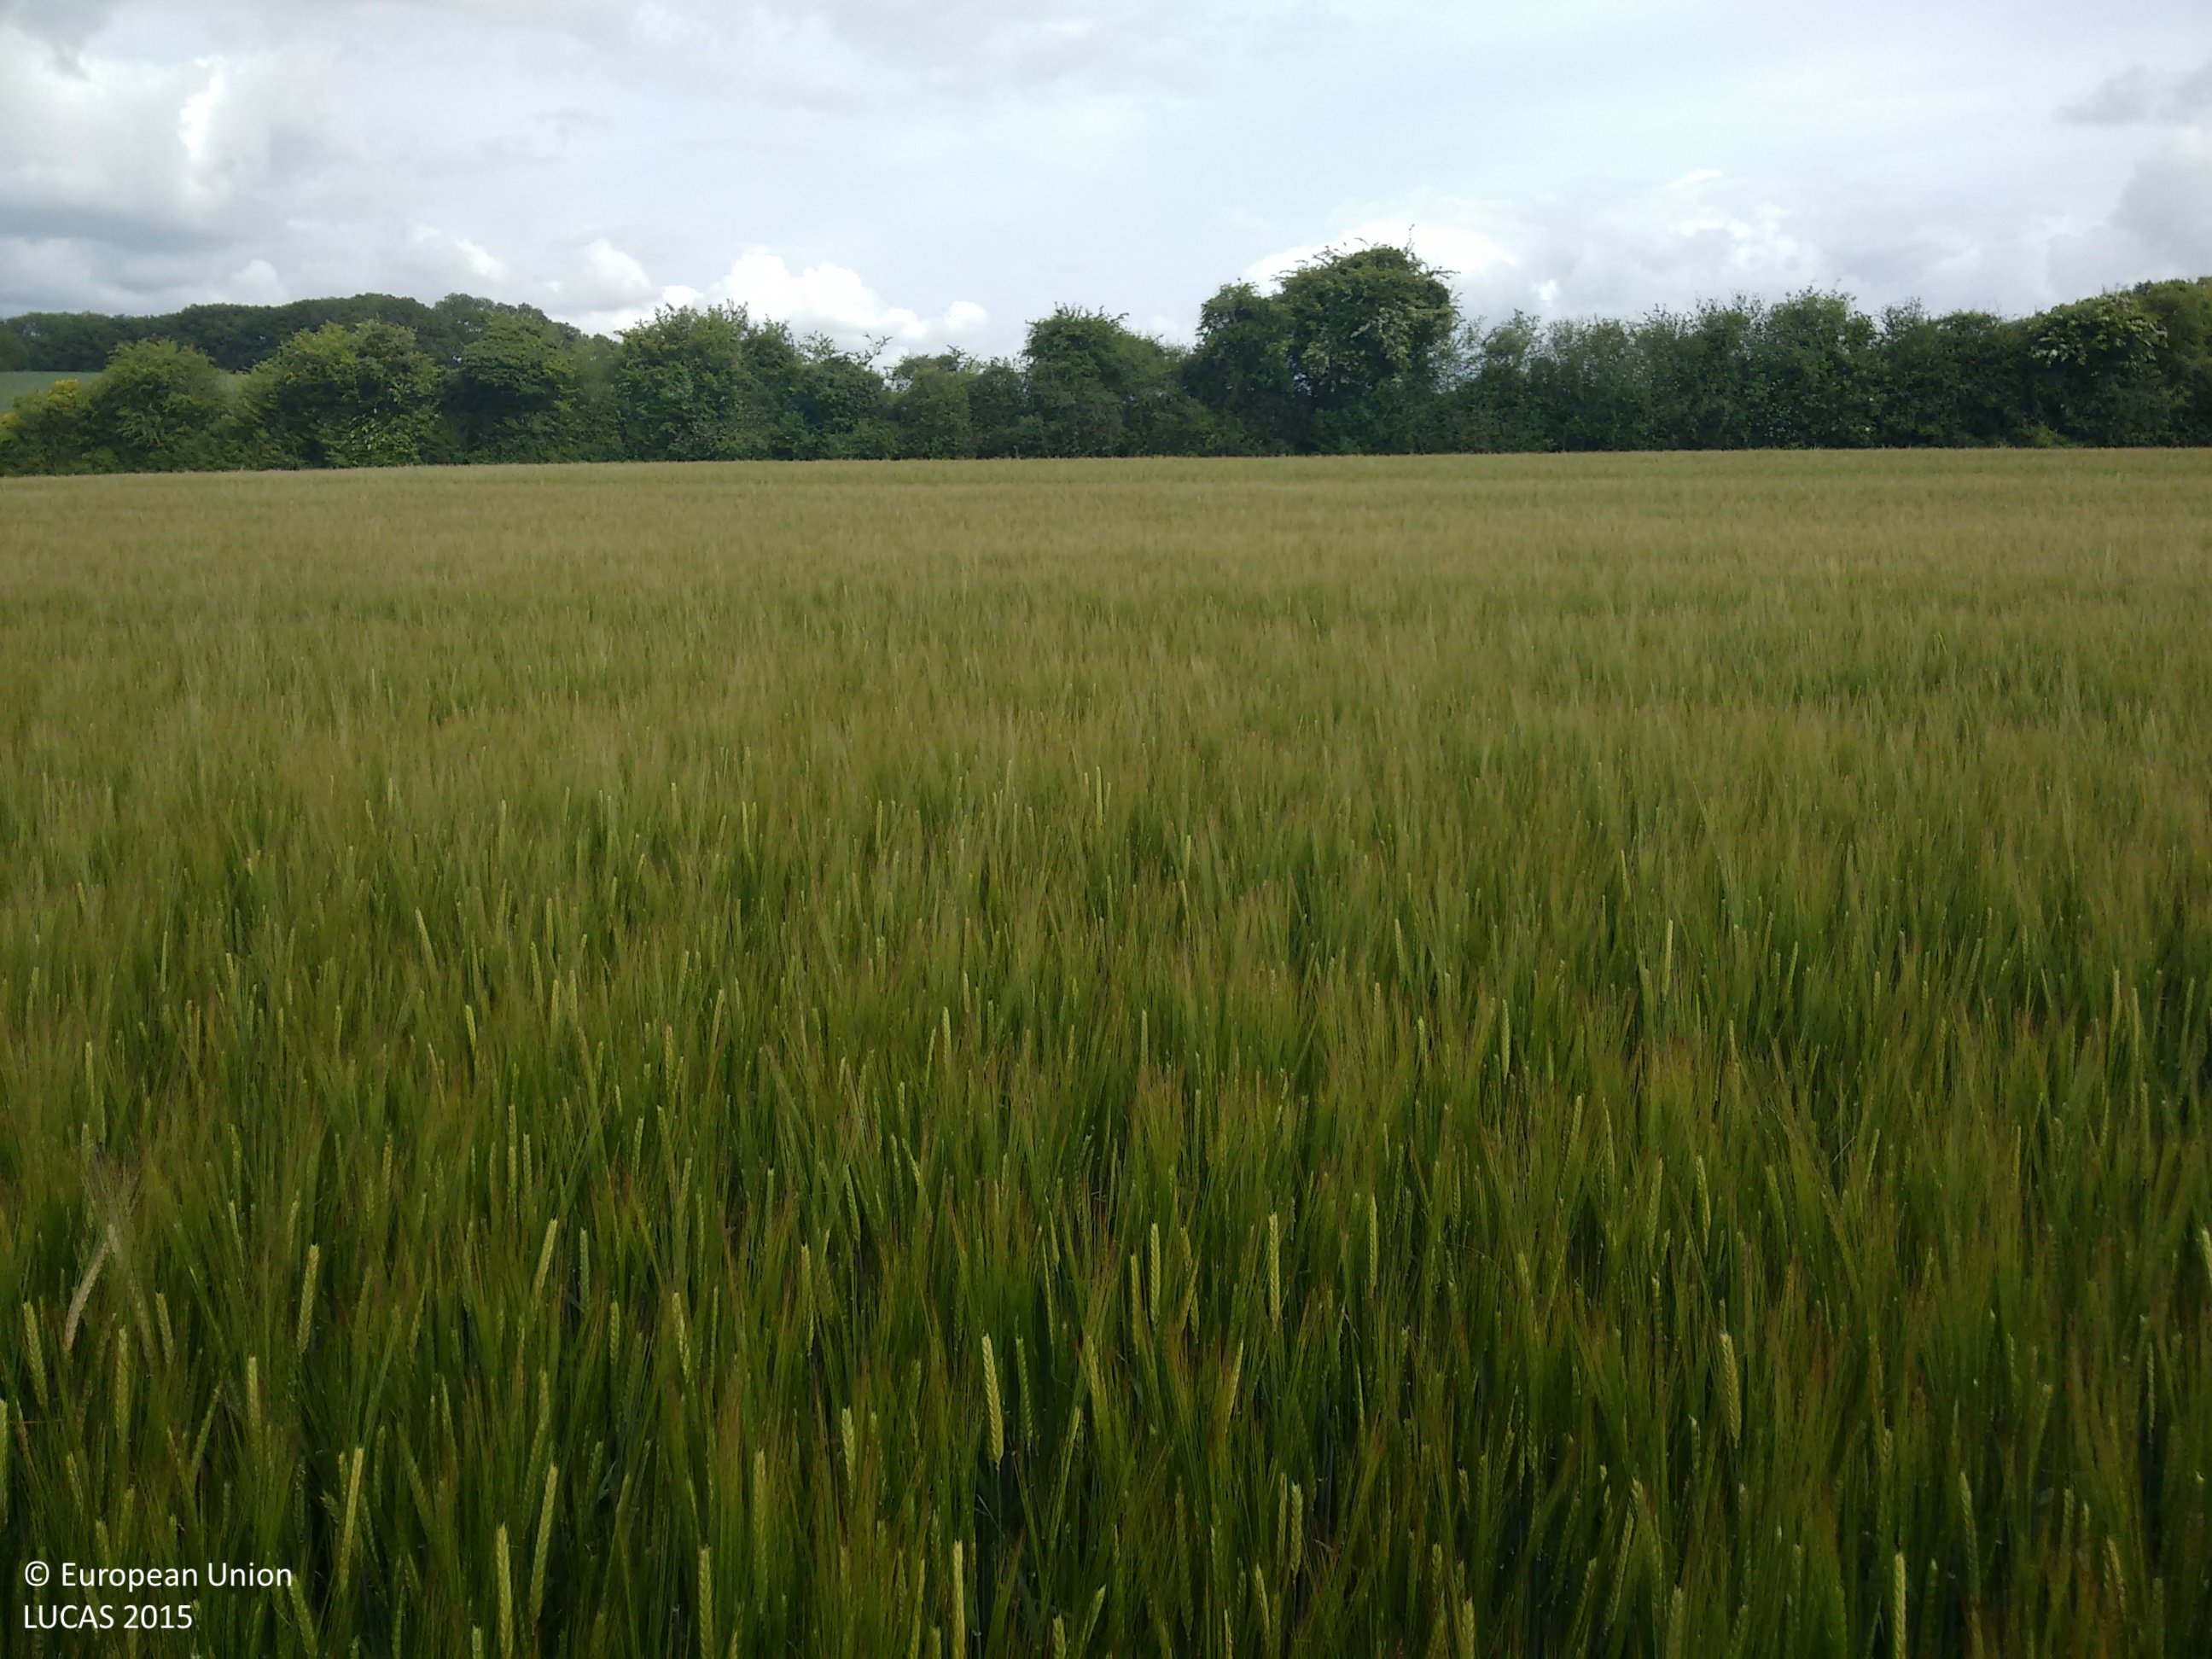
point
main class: Cropland
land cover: Barley
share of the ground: > 75 %
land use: Agriculture (excluding fallow land and kitchen gardens)
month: May
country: GB
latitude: 50.8328
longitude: -2.0569
